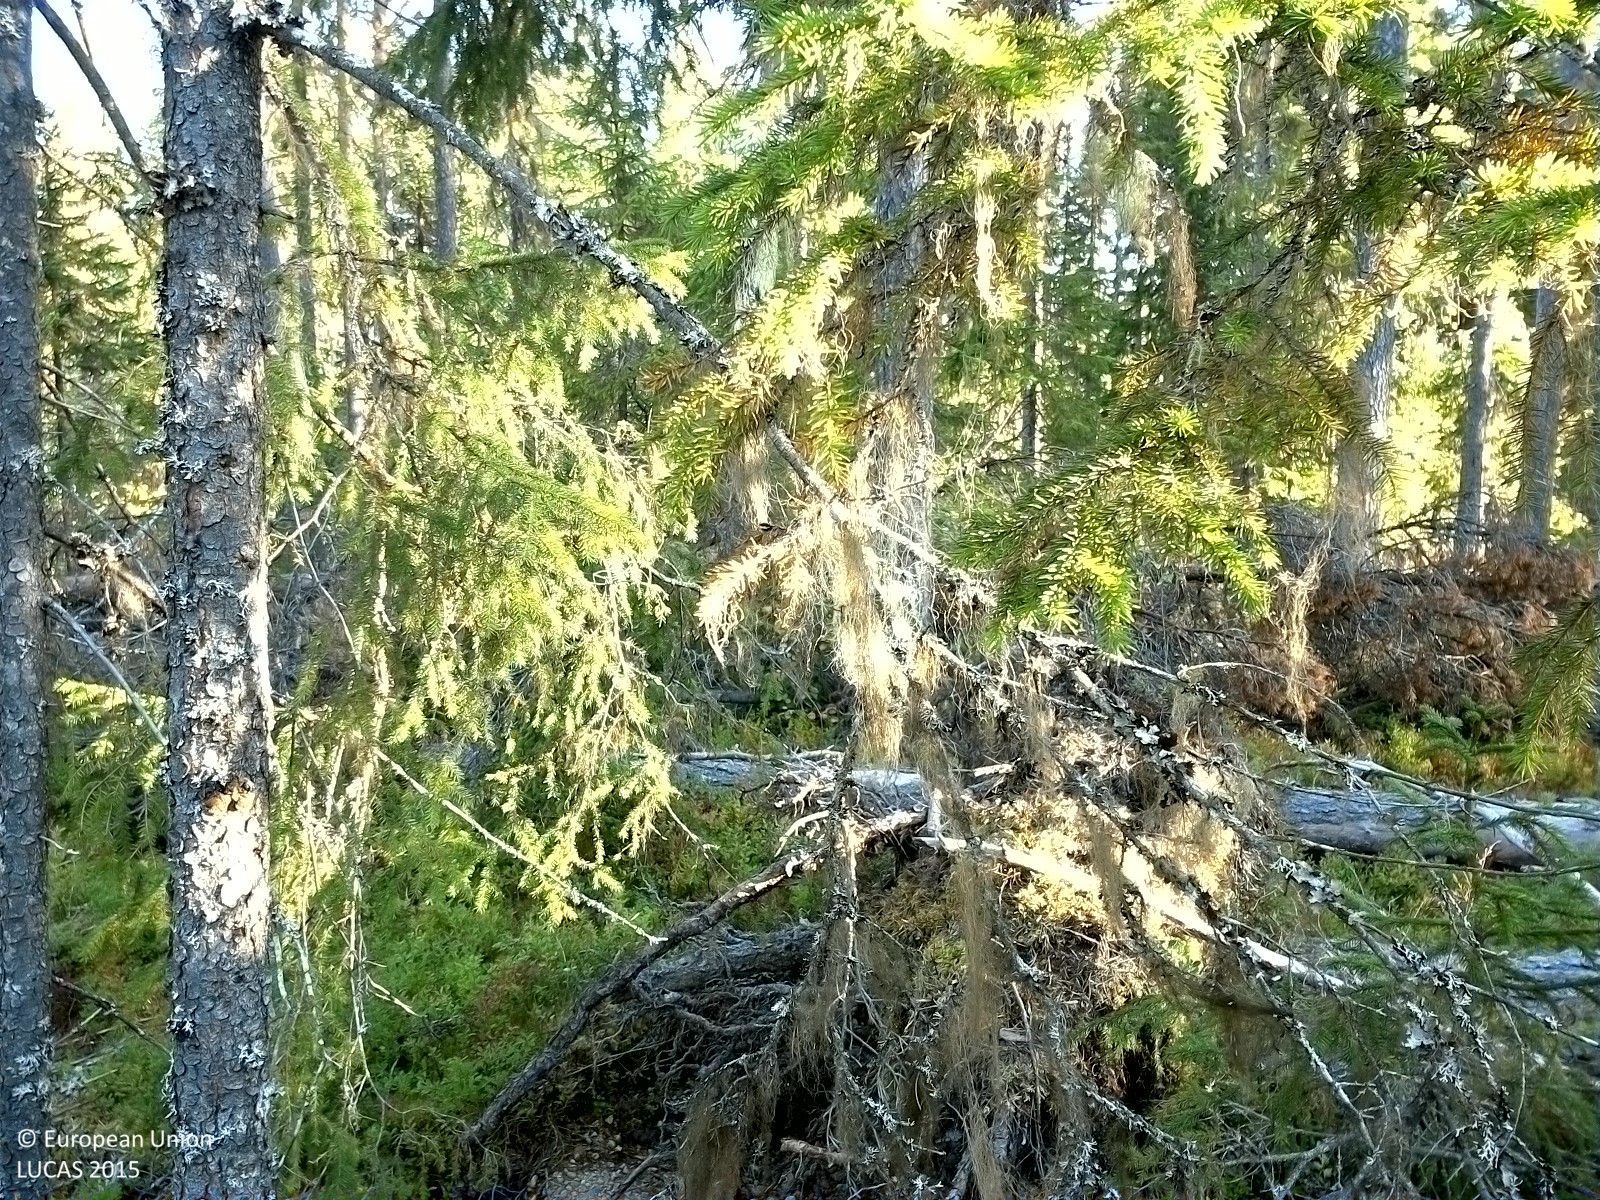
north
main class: Woodland
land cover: Pine dominated coniferous woodland
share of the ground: 25 - 50 %
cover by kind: coniferous forest trees 50 %, lichens and mosses 30 %, shrubs 20 %
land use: Forestry
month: September
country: SE
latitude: 62.5983
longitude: 16.0750
